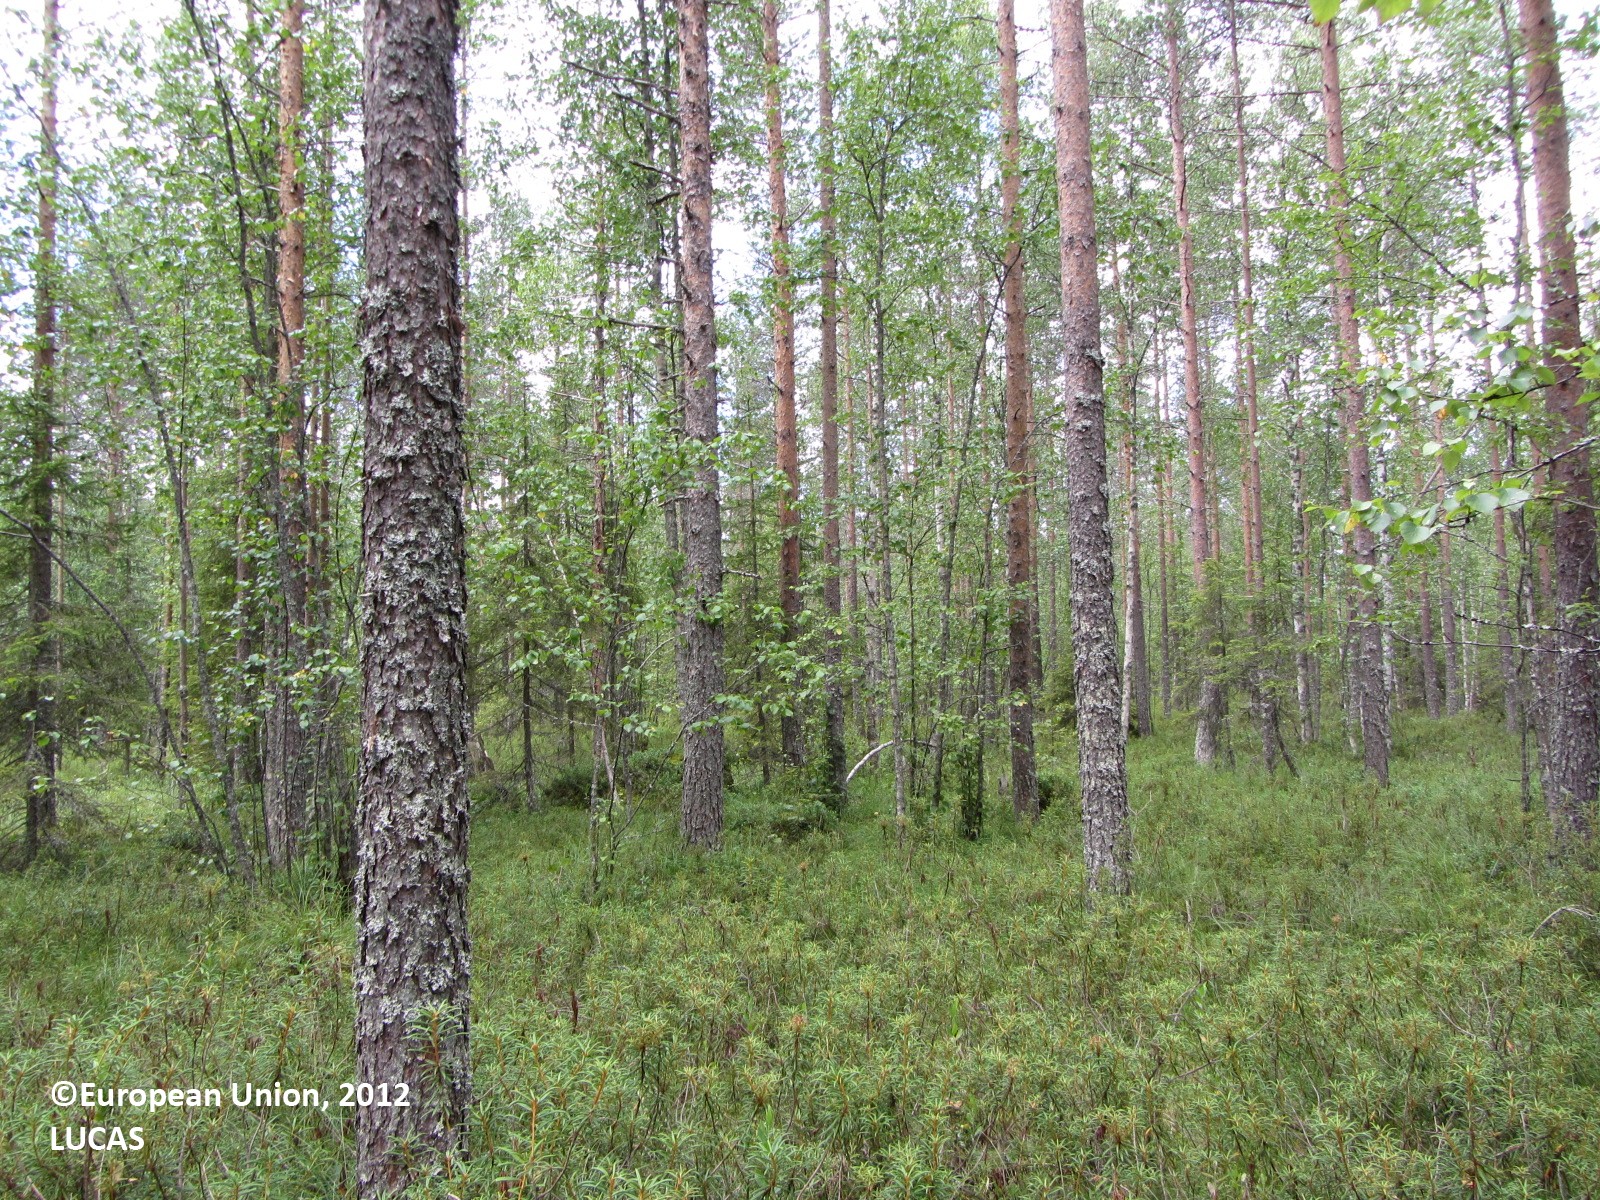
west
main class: Woodland
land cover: Pine dominated mixed woodland
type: mire and swamp forests
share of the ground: > 75 %
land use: Forestry
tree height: > 5 m
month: August
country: FI
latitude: 63.3225
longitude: 25.2503
